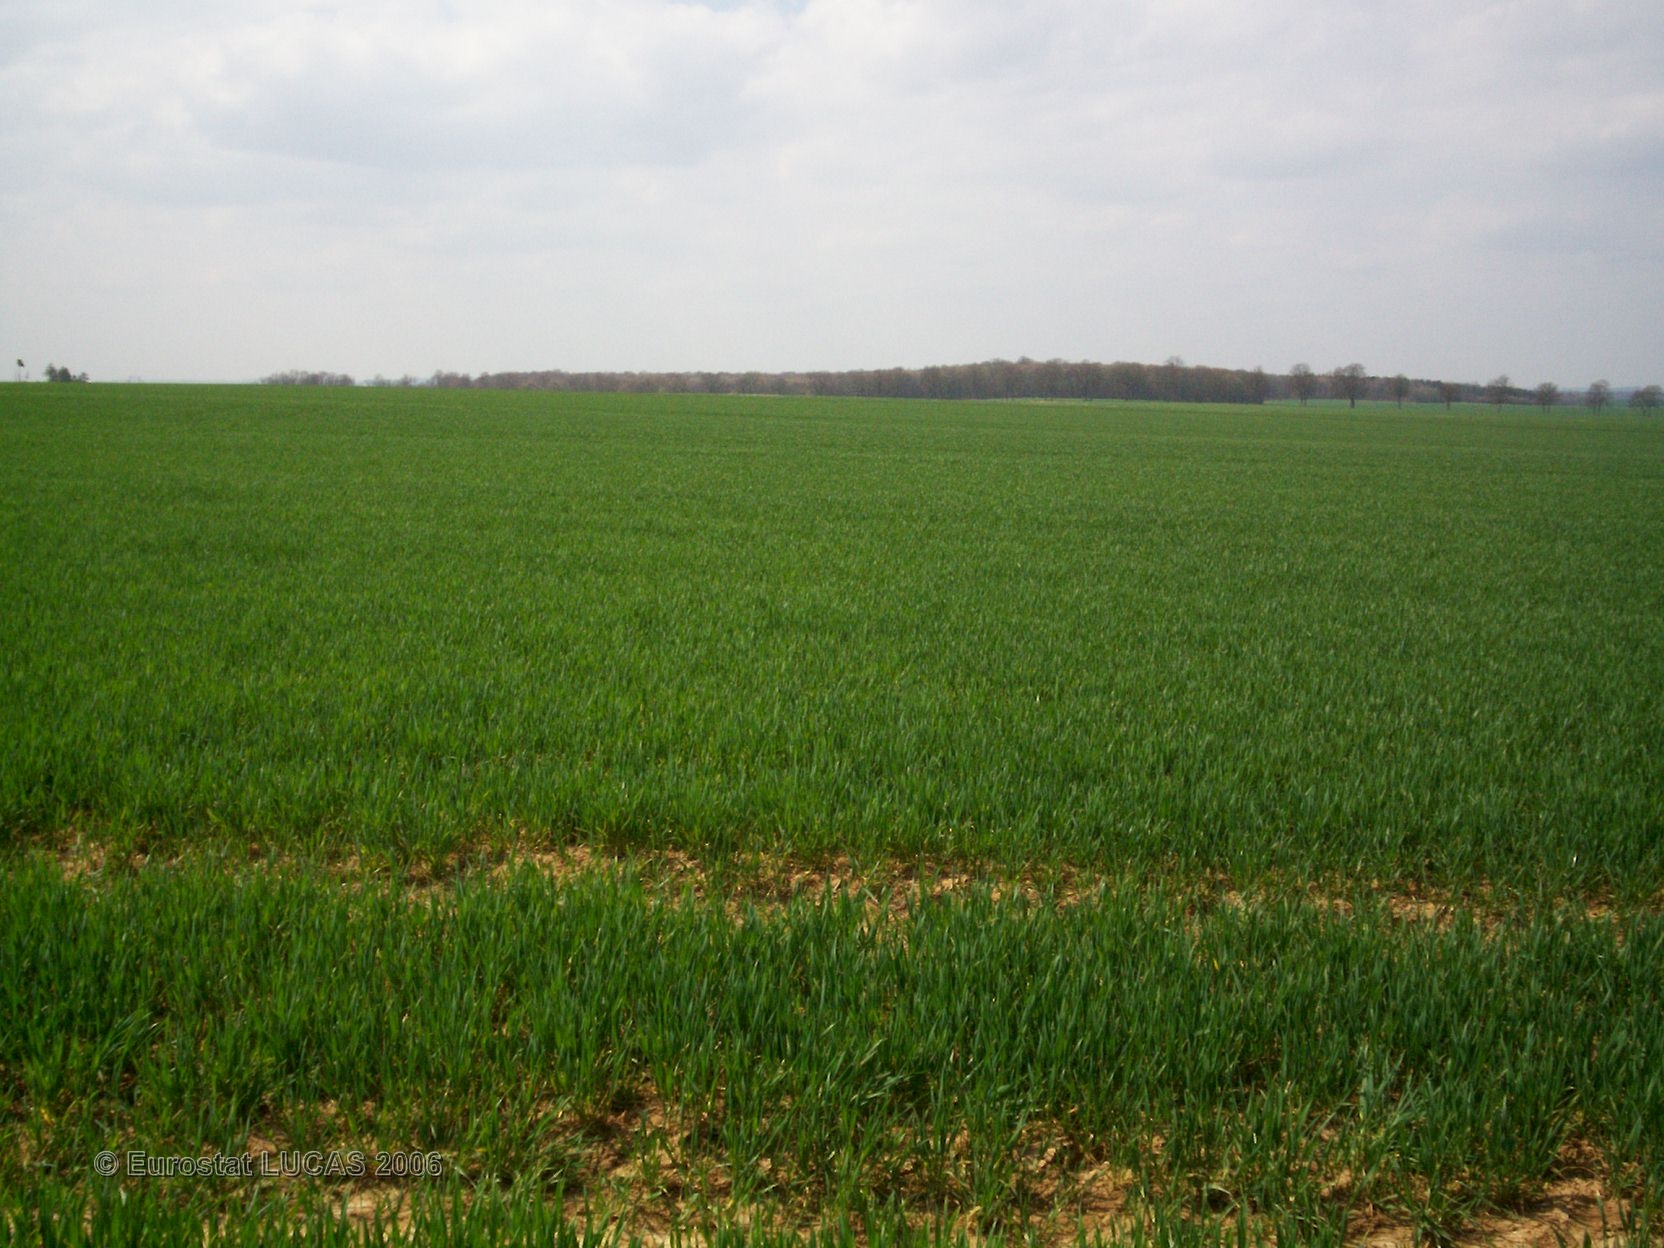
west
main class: Cropland
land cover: Common wheat
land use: Agriculture (excluding fallow land and kitchen gardens)
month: April
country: FR
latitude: 48.8678
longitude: 5.8961
